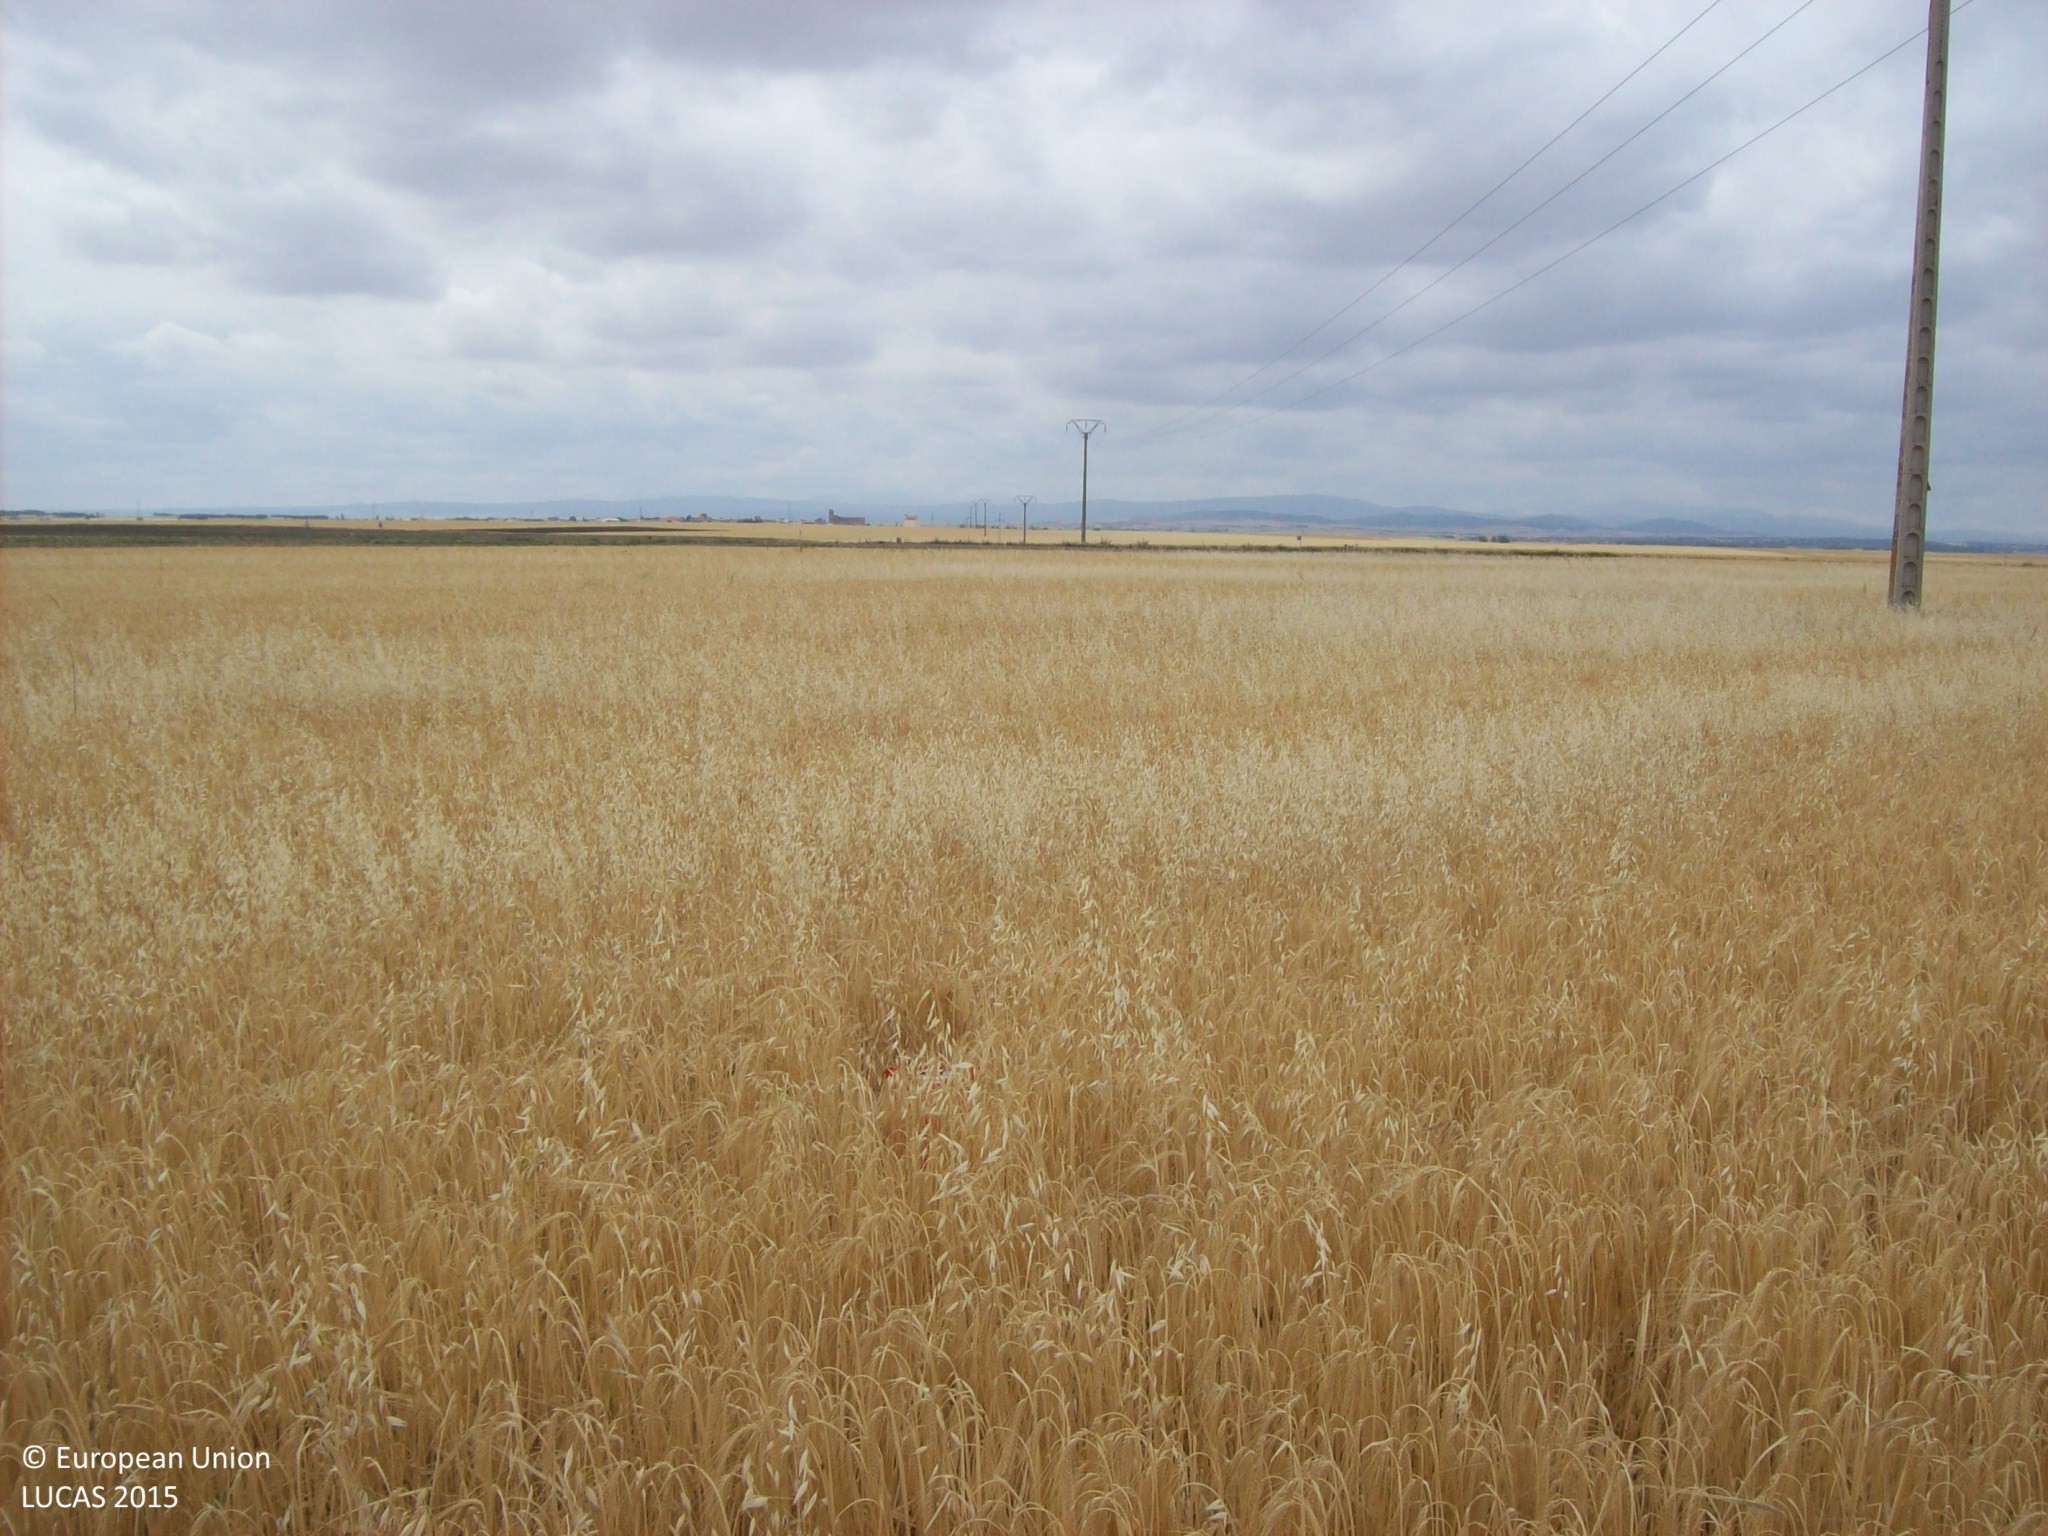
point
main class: Cropland
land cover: Barley
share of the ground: > 75 %
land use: Agriculture (excluding fallow land and kitchen gardens)
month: June
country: ES
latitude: 40.9646
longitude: -4.9765
